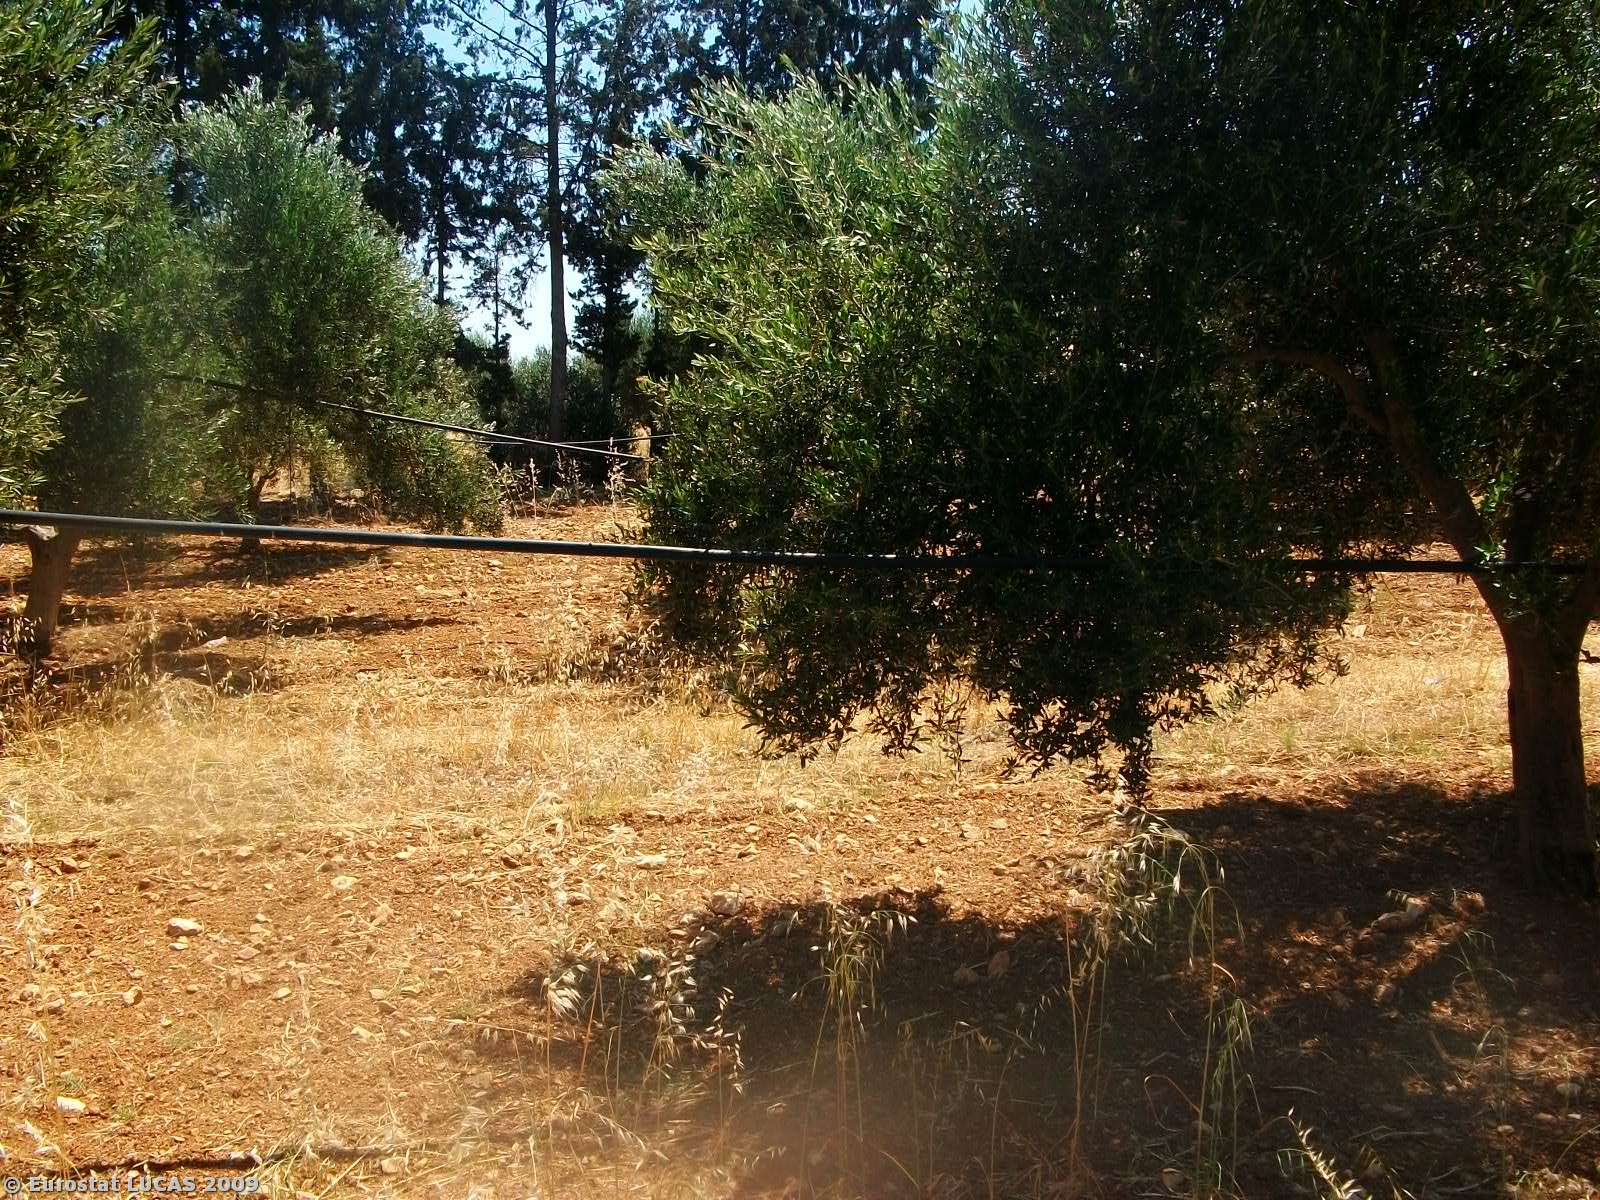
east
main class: Cropland
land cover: Olive groves
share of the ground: > 75 %
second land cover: Bare land
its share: > 75 %
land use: Agriculture (excluding fallow land and kitchen gardens)
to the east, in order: Olive groves; Bare land; Grass margins; Olive groves; Bare land; Paved roads, cycling and walking lanes; Bare land; Olive groves; Bare land; Vineyards; Bare land
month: June
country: GR
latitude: 35.0155
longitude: 24.9214
